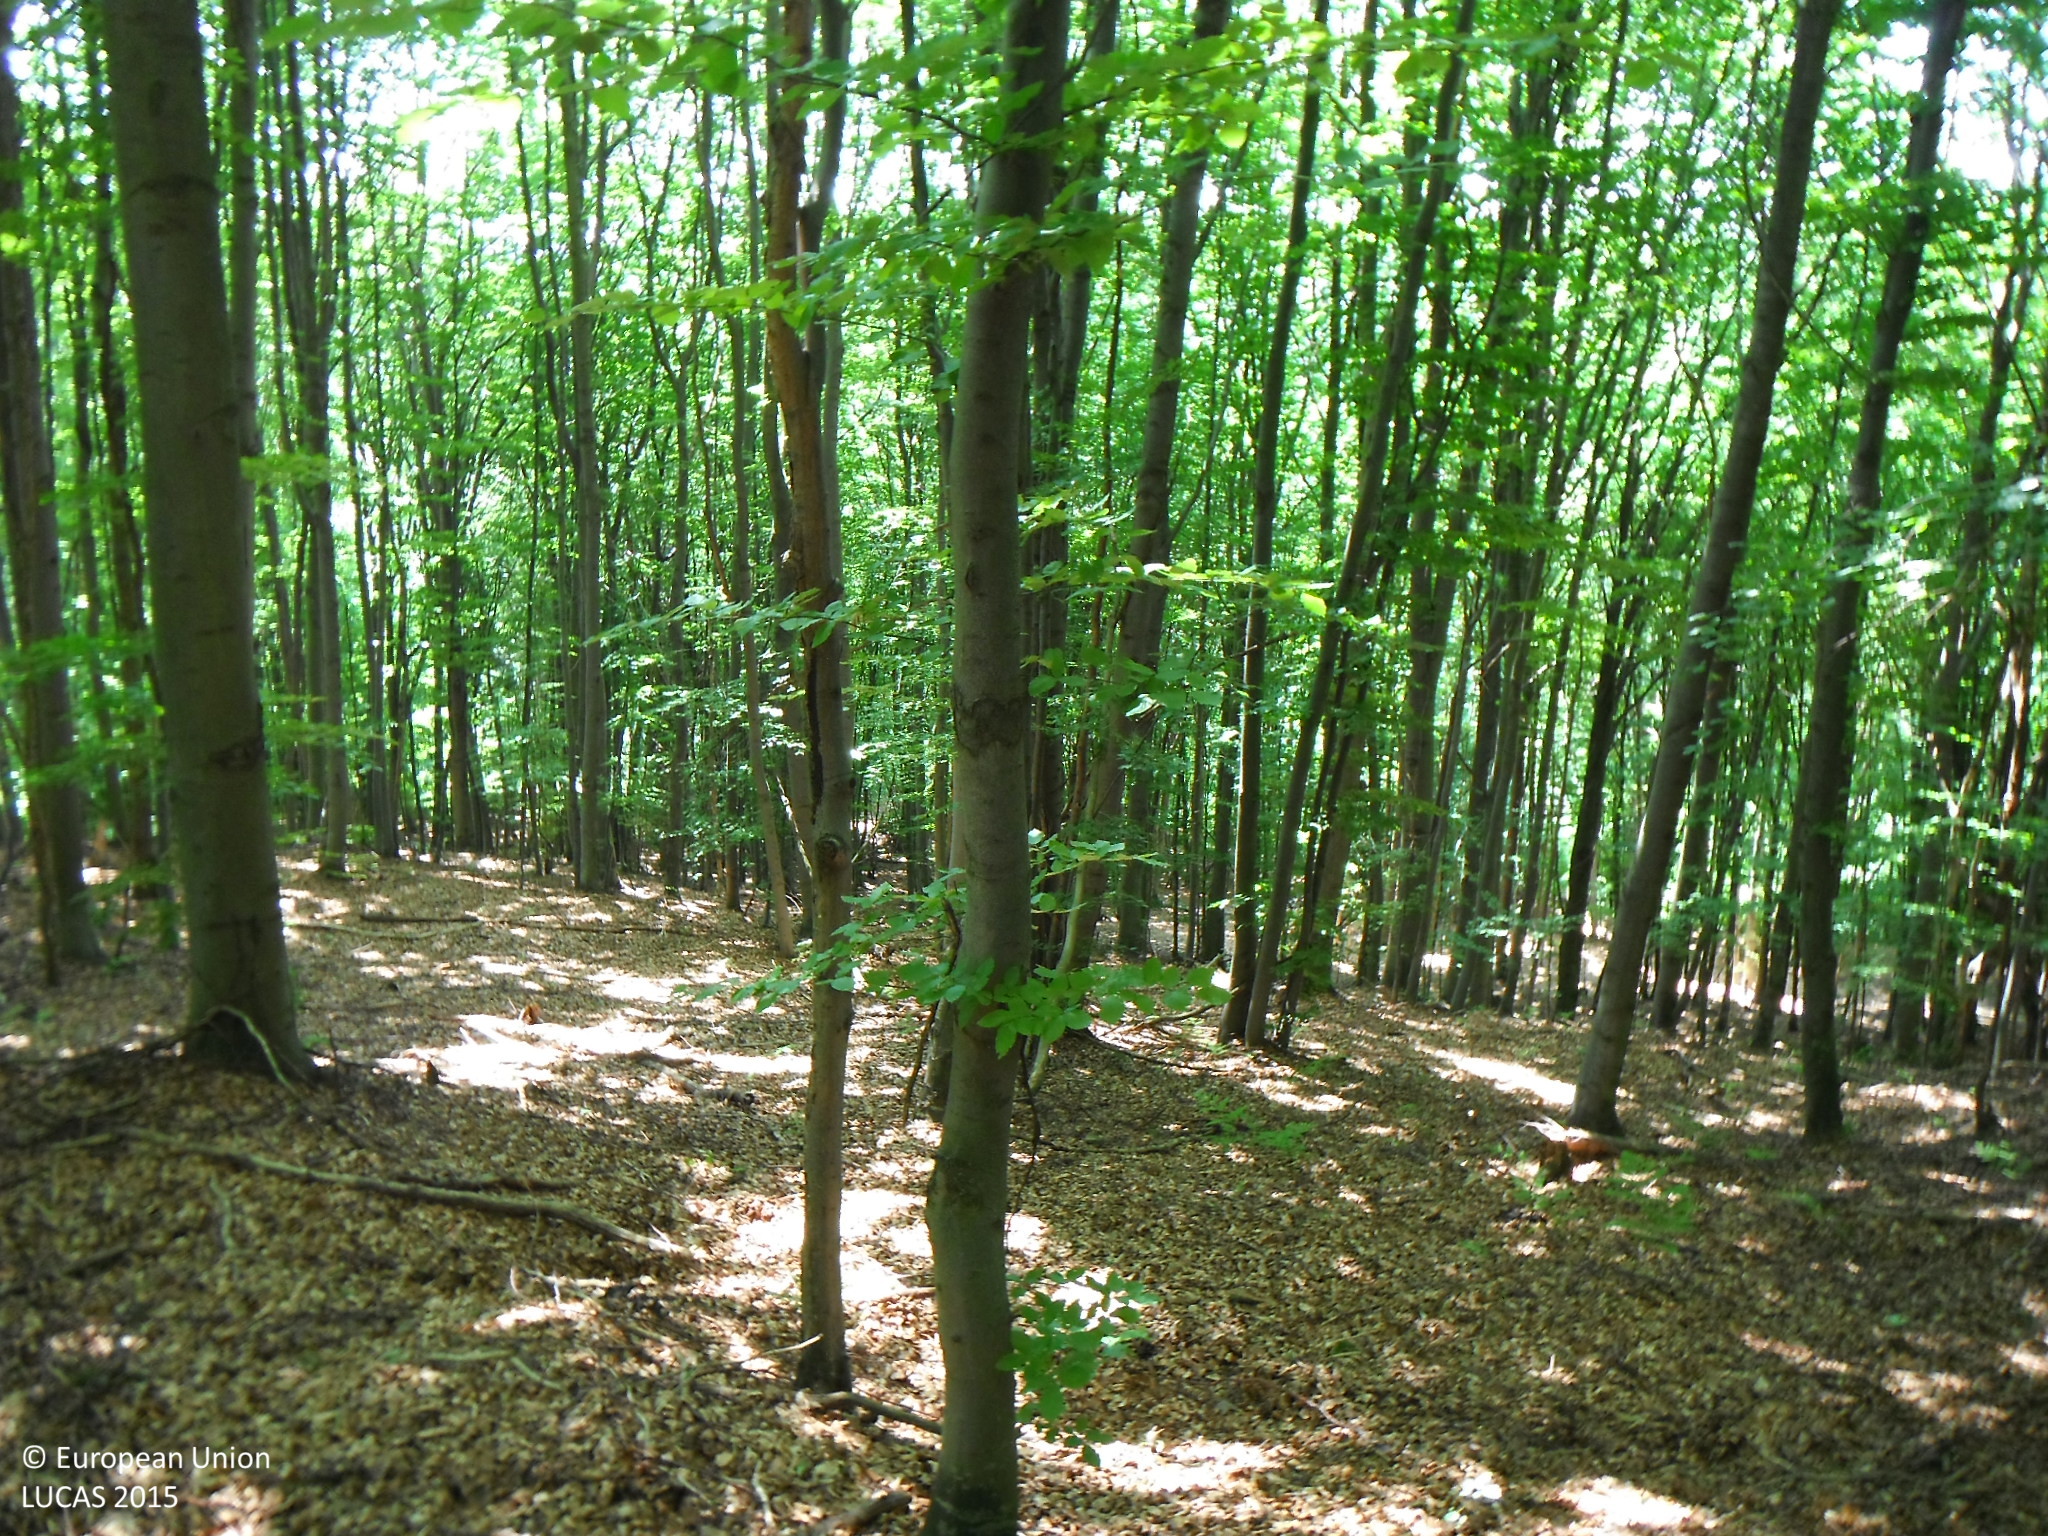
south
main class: Woodland
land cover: Broadleaved woodland
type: beech forest
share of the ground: > 75 %
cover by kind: broadleaved forest trees 100 %
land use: Forestry
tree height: > 5 m
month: July
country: SK
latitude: 49.3775
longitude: 21.1878
